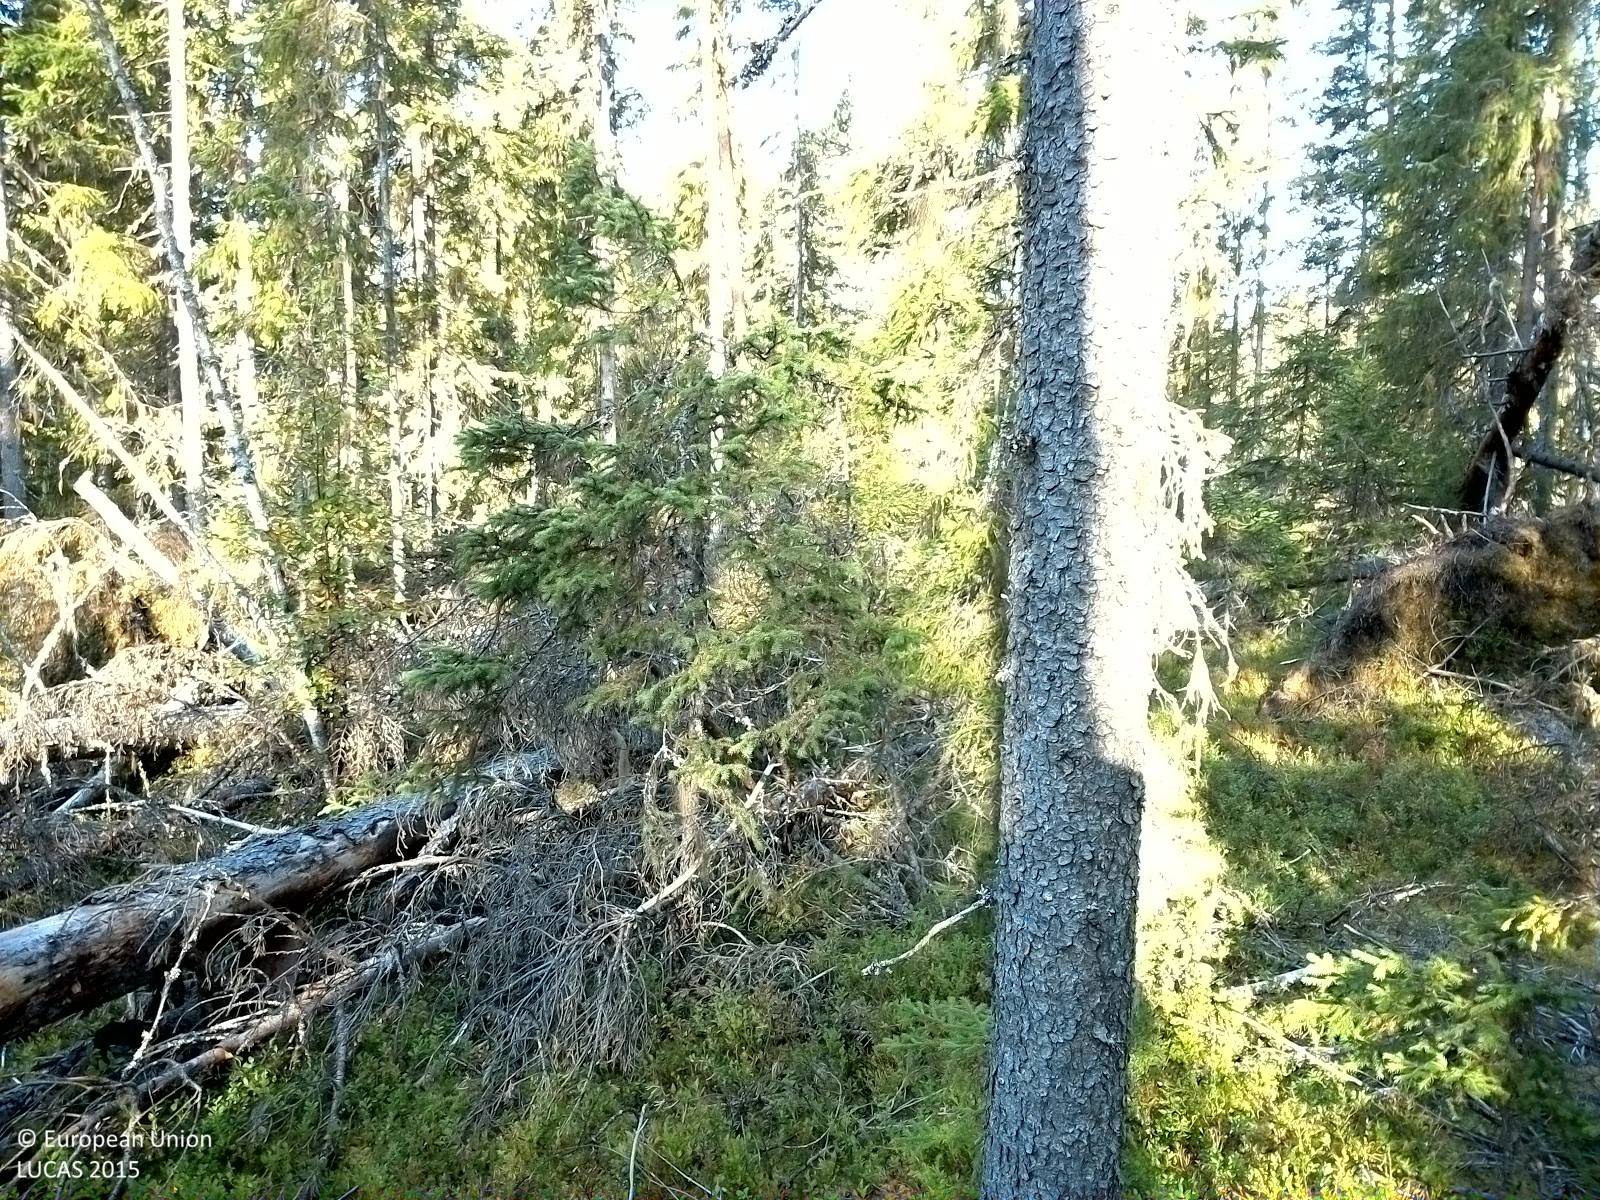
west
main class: Woodland
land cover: Pine dominated coniferous woodland
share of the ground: 25 - 50 %
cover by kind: coniferous forest trees 50 %, lichens and mosses 30 %, shrubs 20 %
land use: Forestry
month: September
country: SE
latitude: 62.5983
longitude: 16.0750
